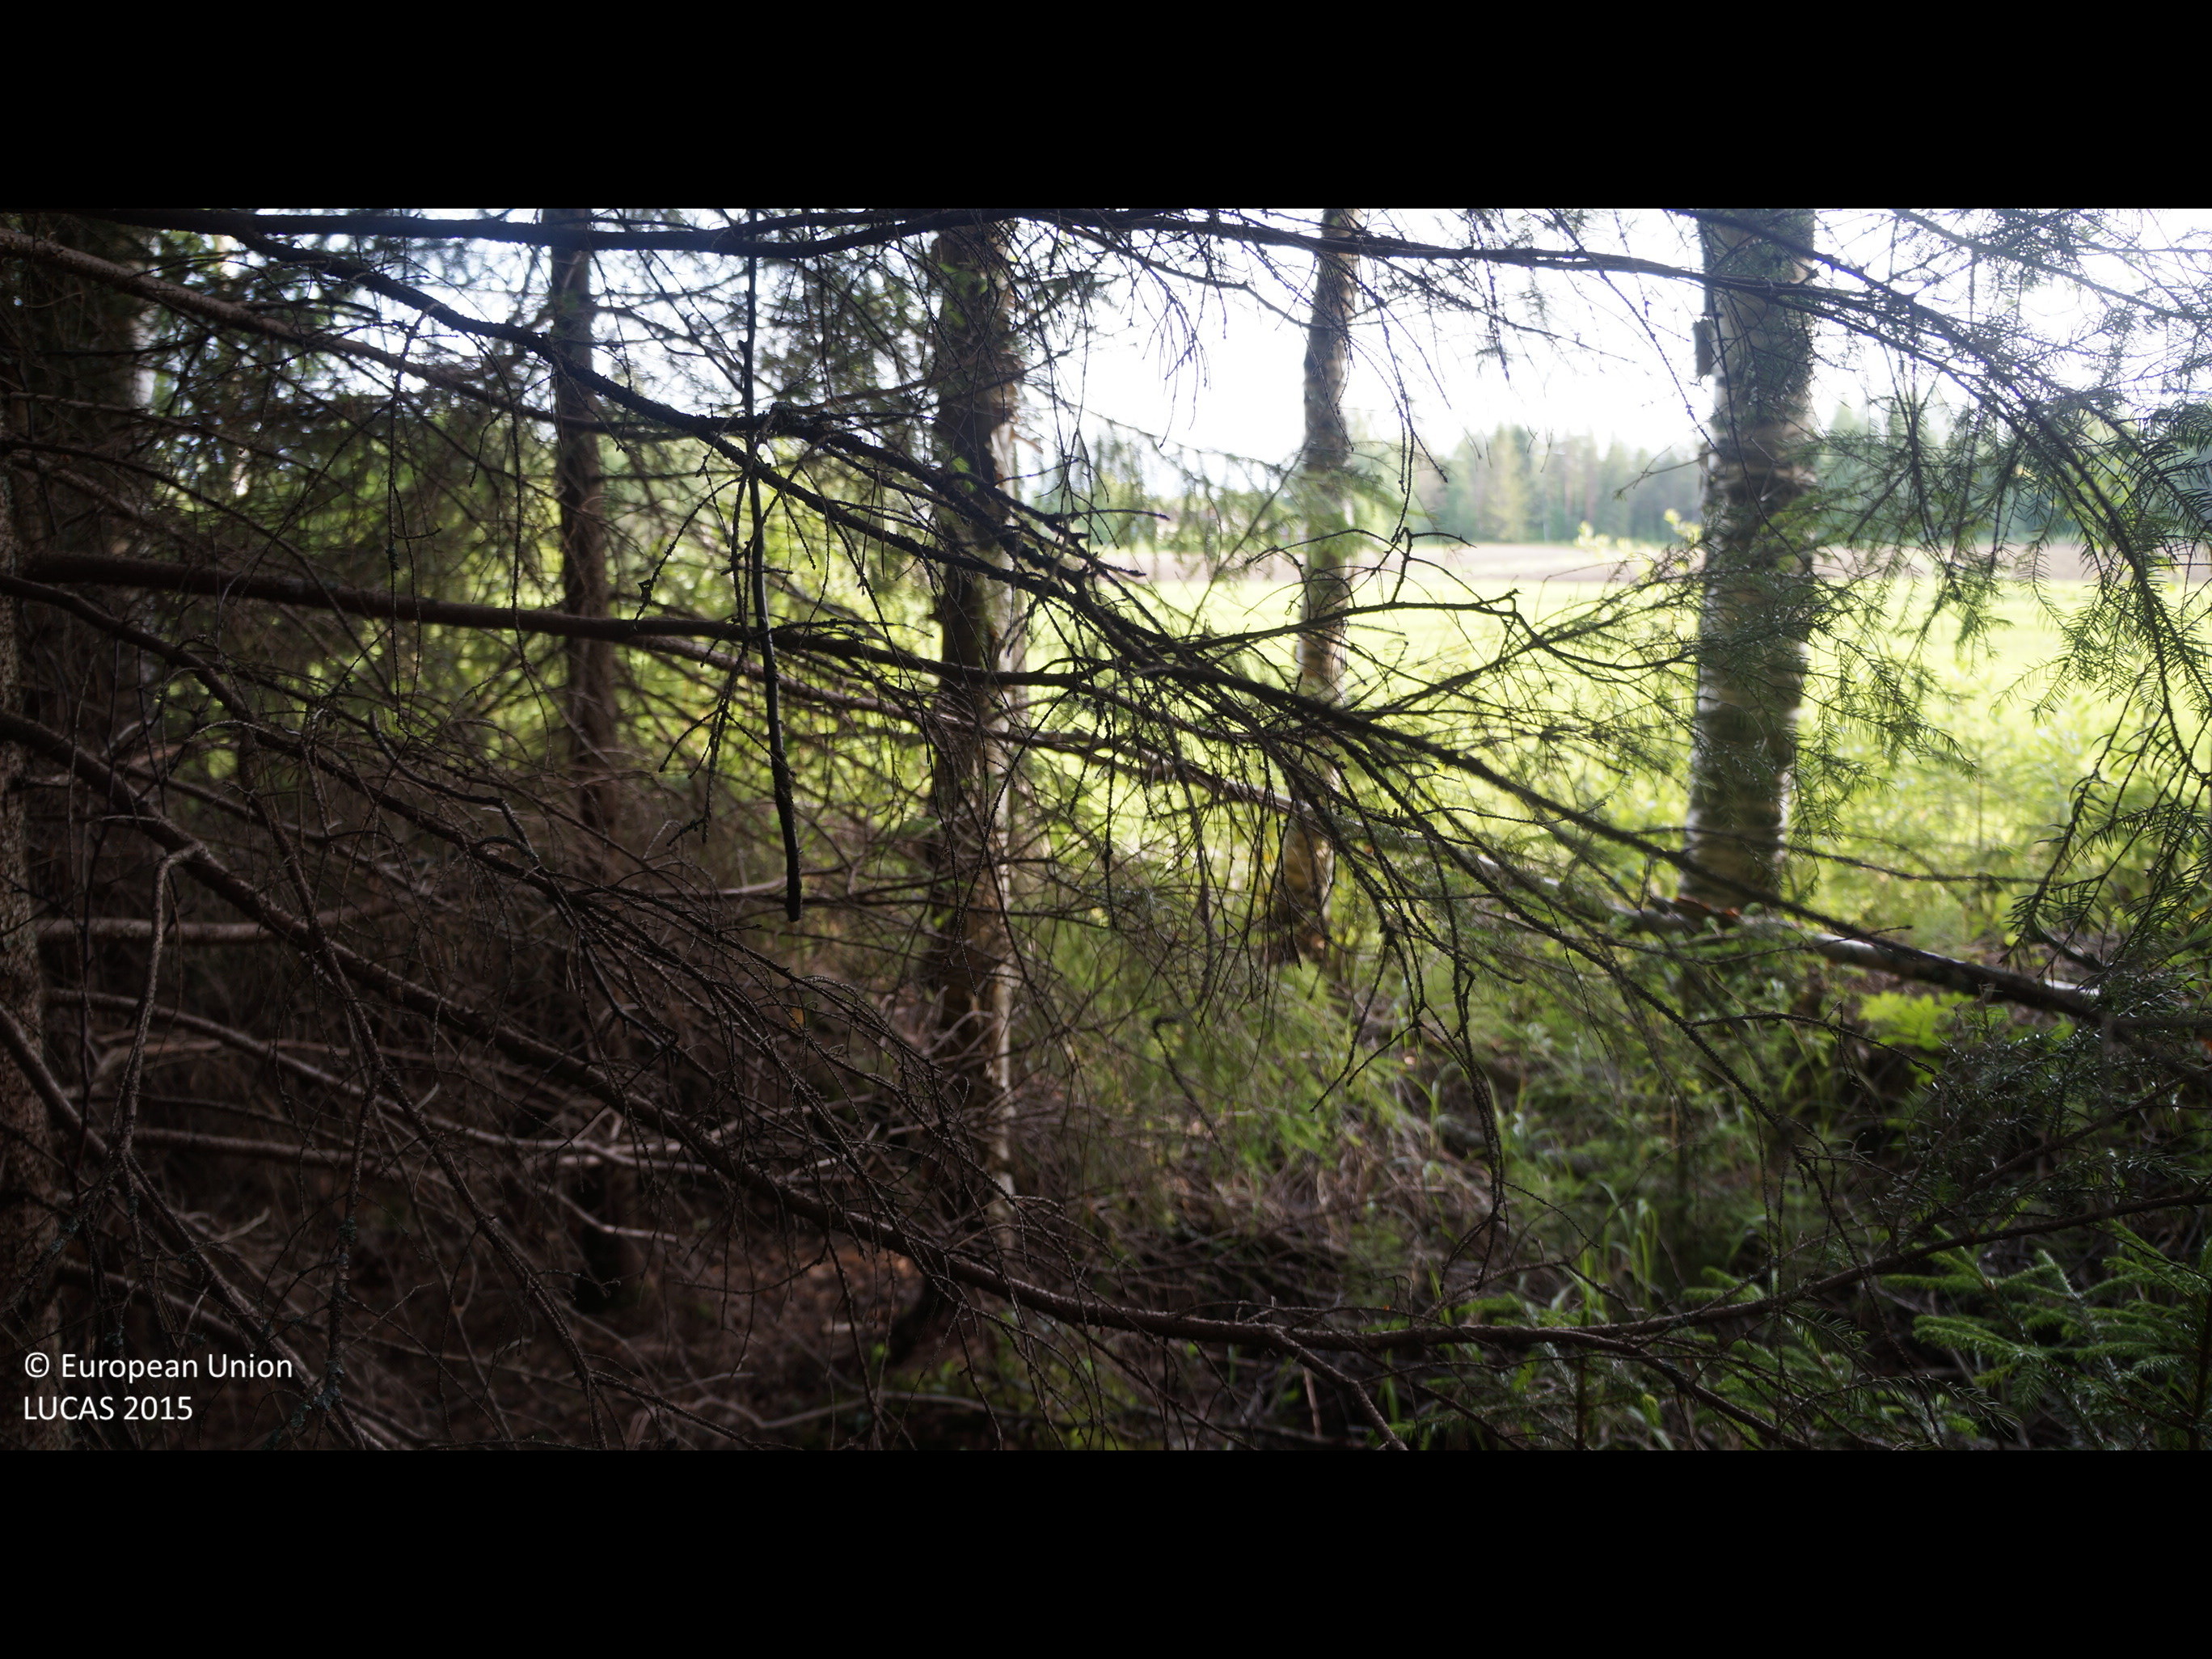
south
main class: Woodland
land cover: Spruce dominated mixed woodland
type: boreal forest
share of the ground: > 75 %
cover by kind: coniferous forest trees 50 %, broadleaved forest trees 35 %, shrubs 10 %, lichens and mosses 5 %
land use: Forestry
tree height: > 5 m
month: July
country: FI
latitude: 64.6488
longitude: 24.7031
